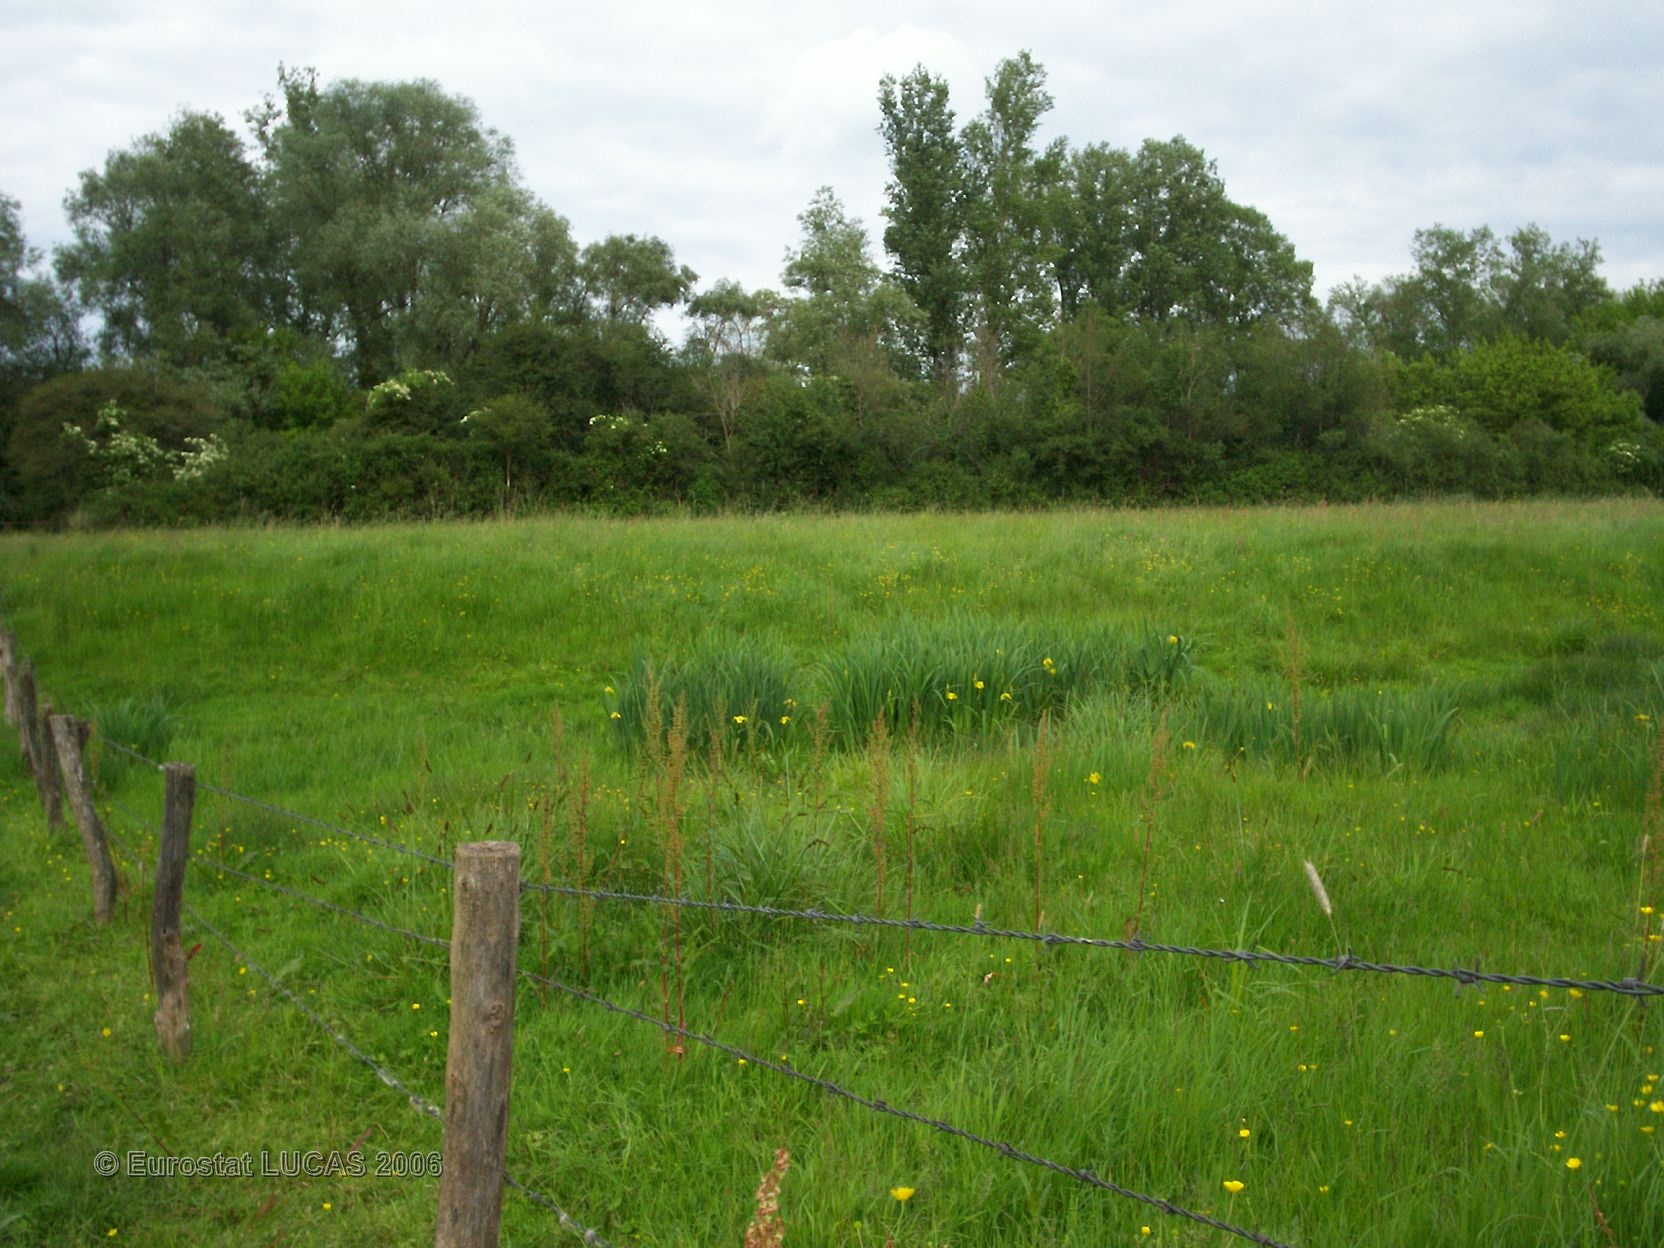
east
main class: Grassland
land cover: Grassland without tree/shrub cover
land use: Agriculture (excluding fallow land and kitchen gardens)
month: May
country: FR
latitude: 46.9023
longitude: 3.0518
